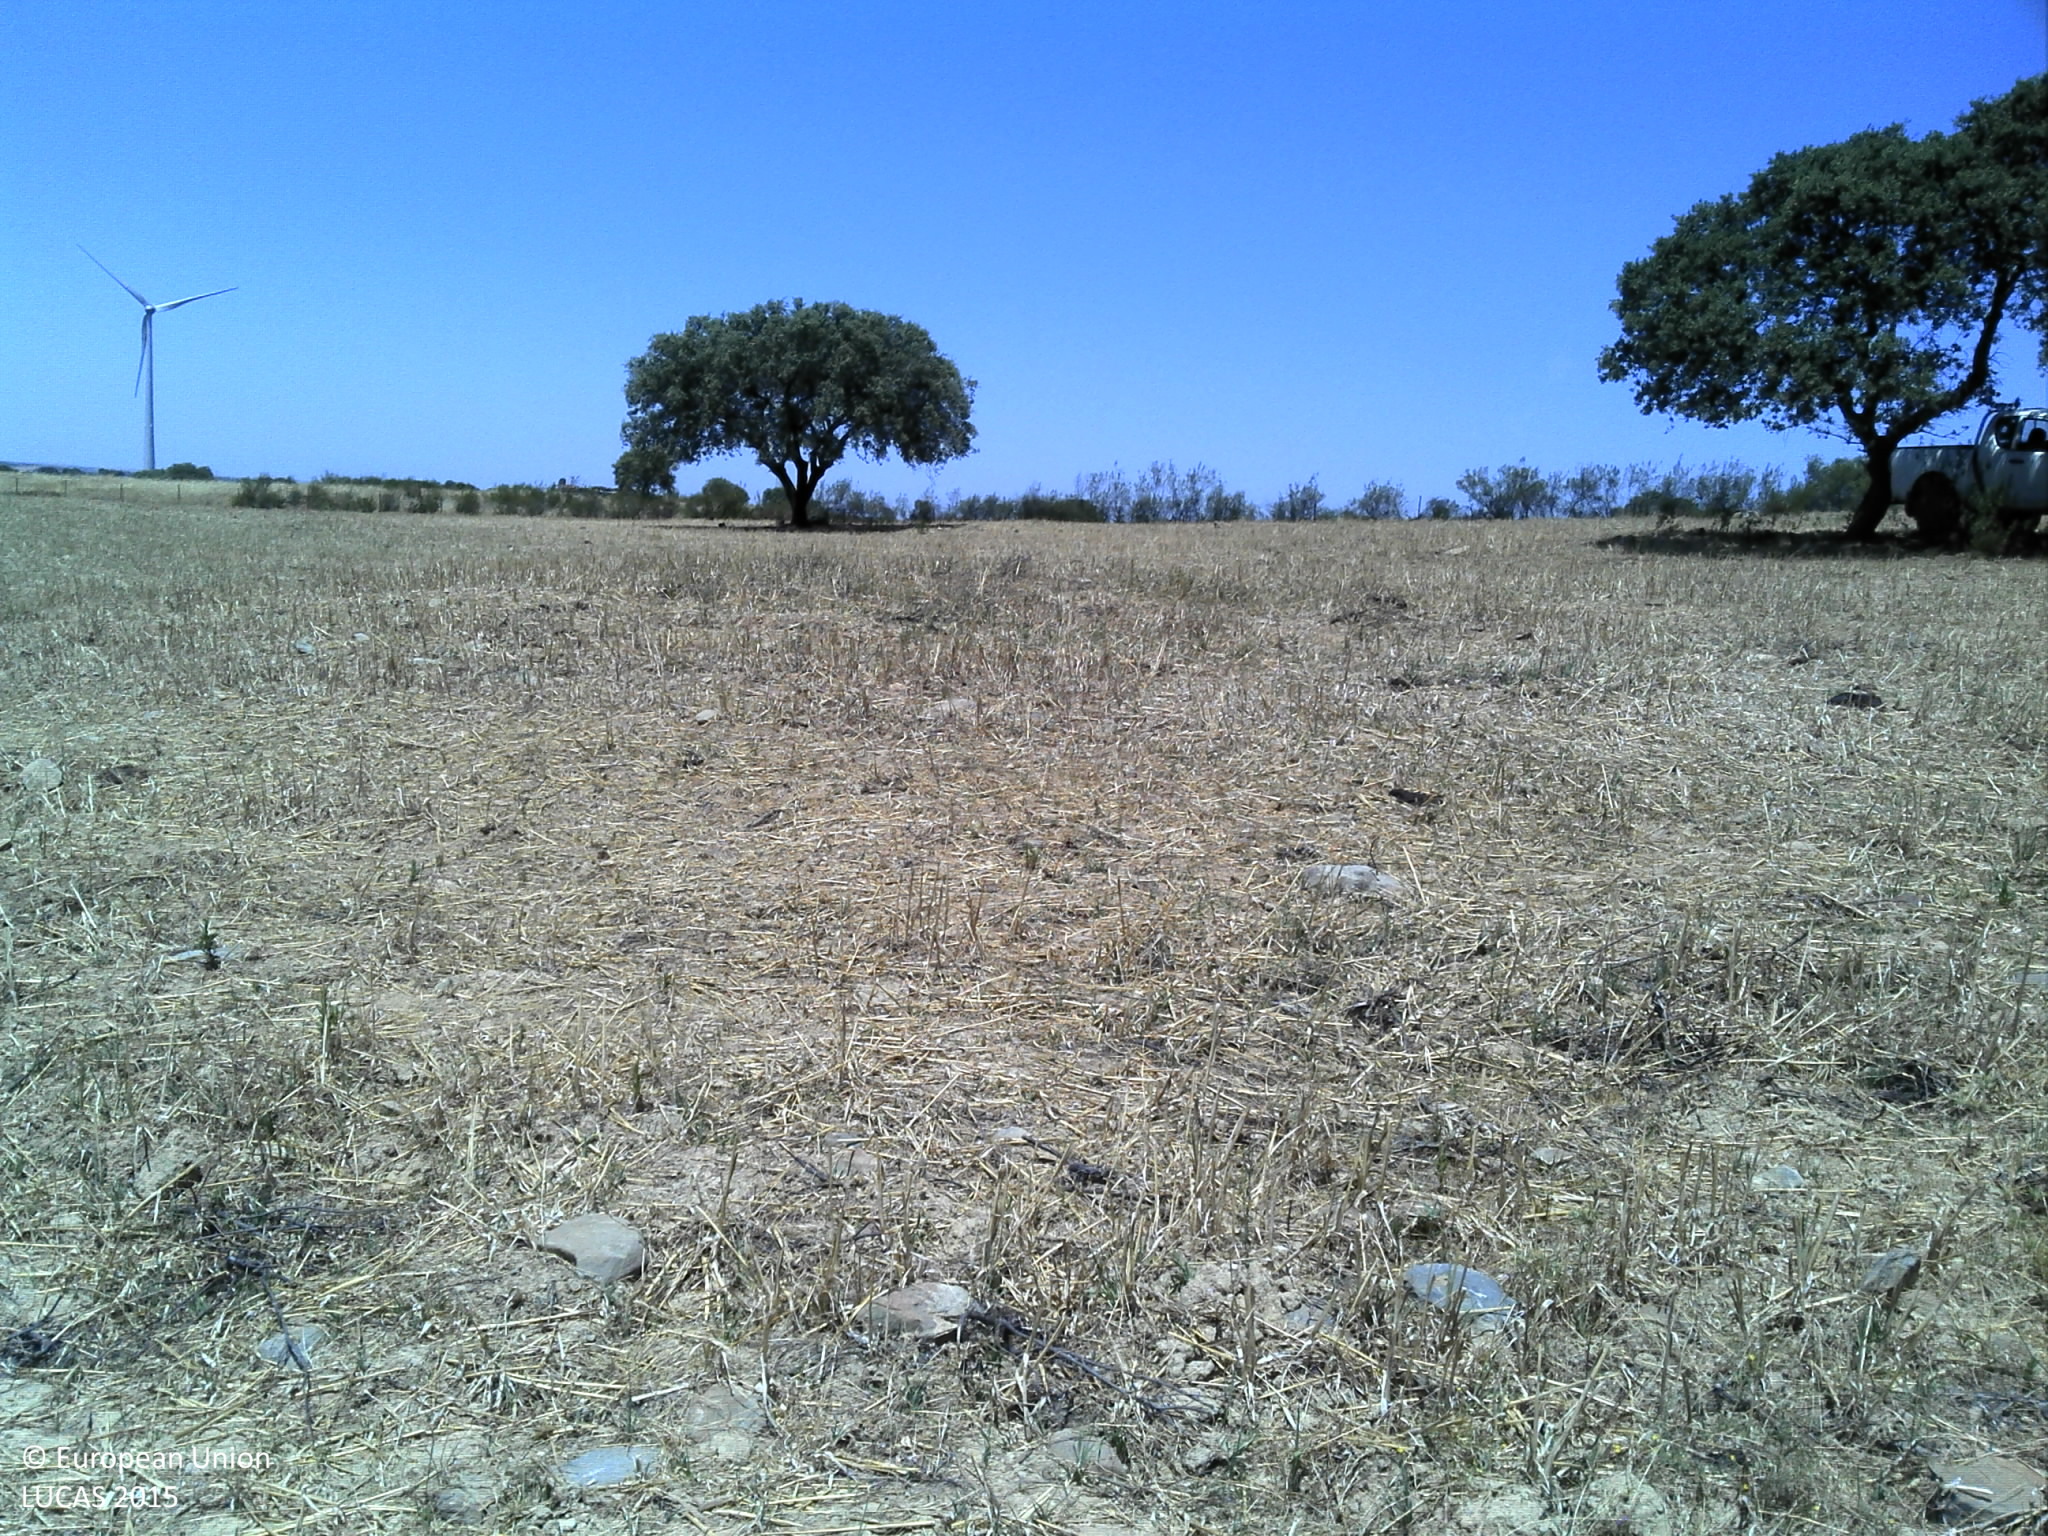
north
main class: Cropland
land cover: Oats
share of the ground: 50 - 75 %
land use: Agriculture (excluding fallow land and kitchen gardens)
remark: Harvested field
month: July
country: PT
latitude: 37.5047
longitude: -7.8566
